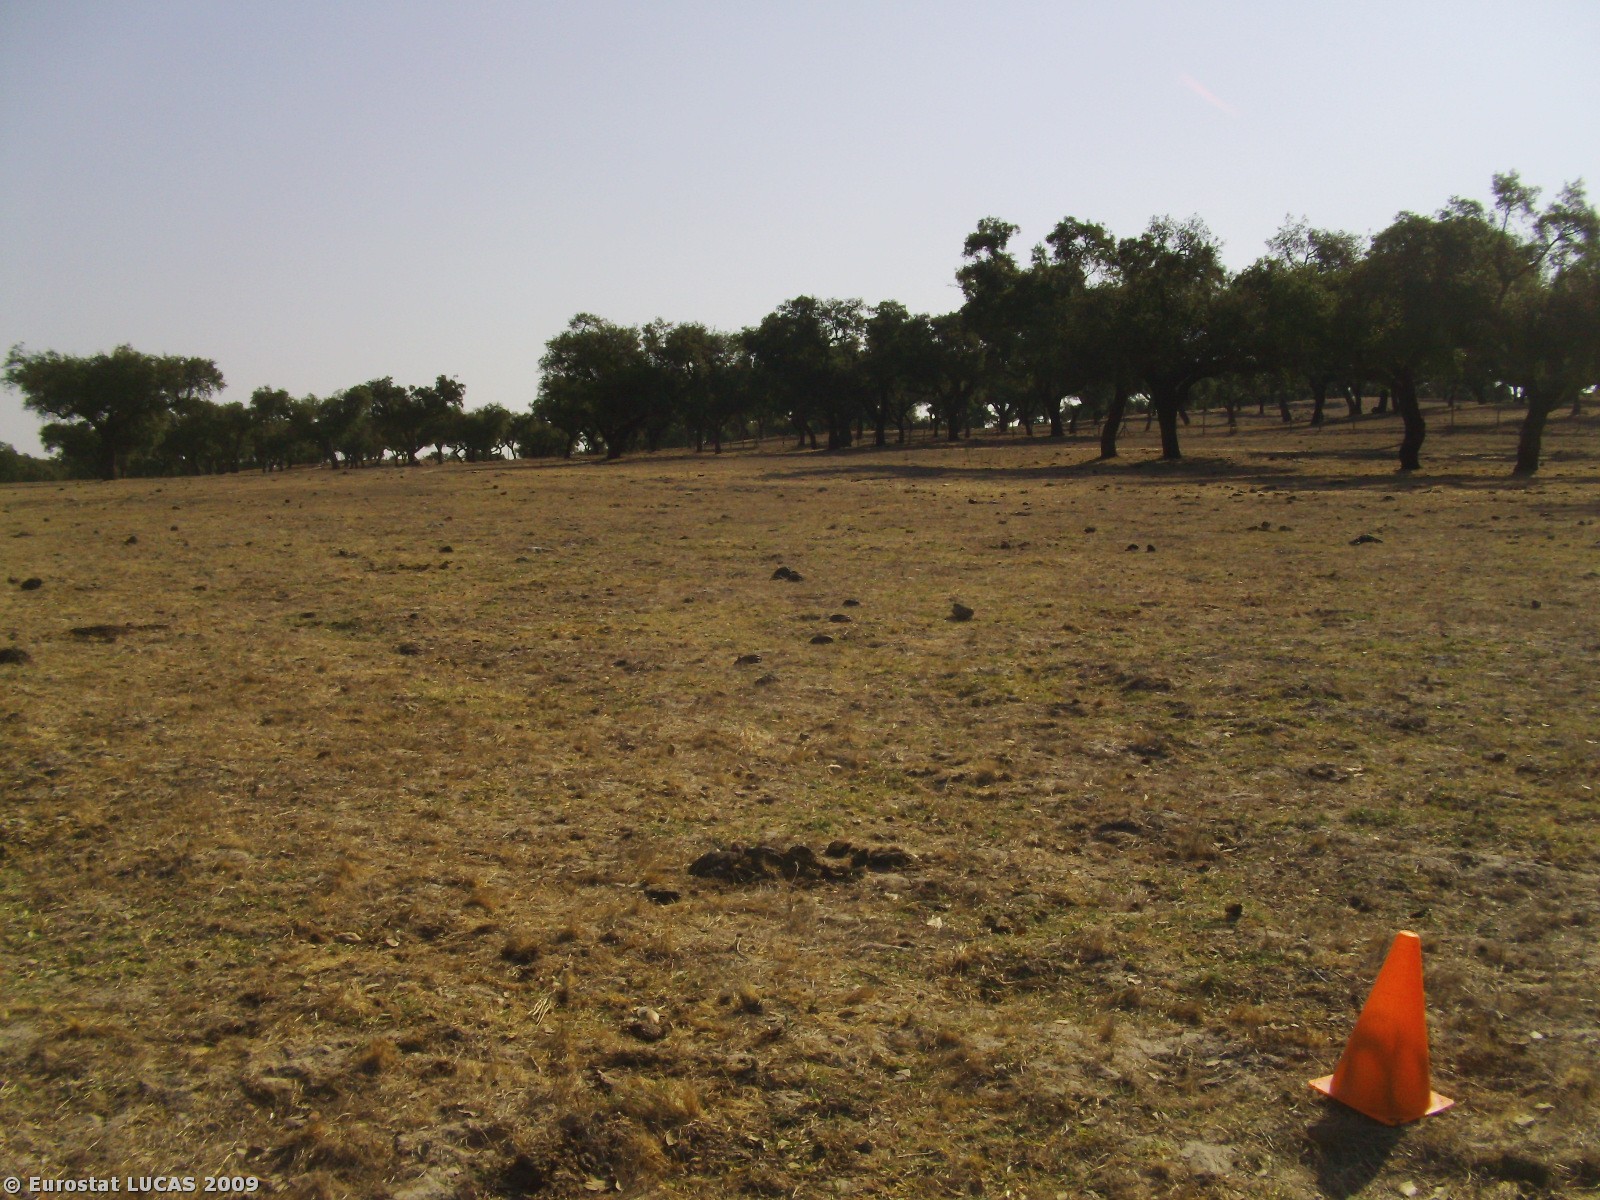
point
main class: Grassland
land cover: Grassland without tree/shrub cover
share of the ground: < 10 %
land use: Agriculture (excluding fallow land and kitchen gardens)
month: August
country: PT
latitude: 38.4139
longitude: -7.9378
